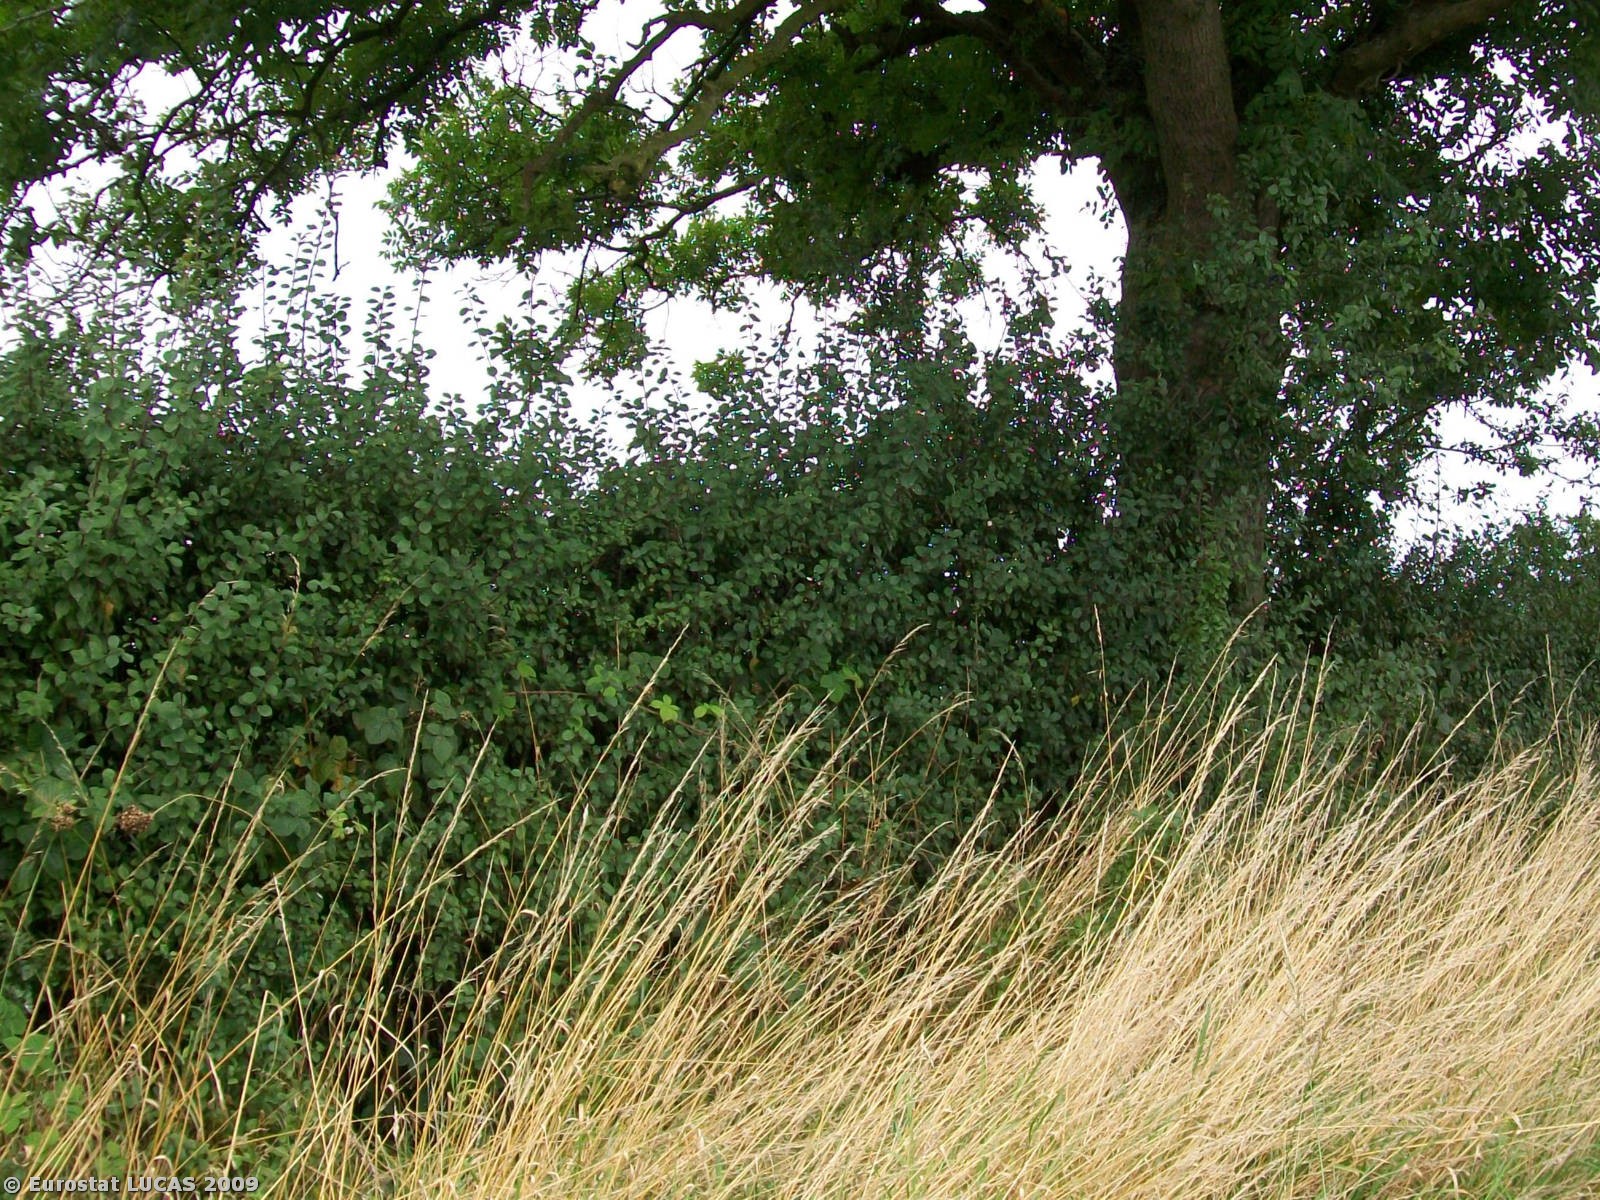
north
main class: Cropland
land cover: Sugar beet
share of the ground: > 75 %
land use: Agriculture (excluding fallow land and kitchen gardens)
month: August
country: GB
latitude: 53.6854
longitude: -0.3161
